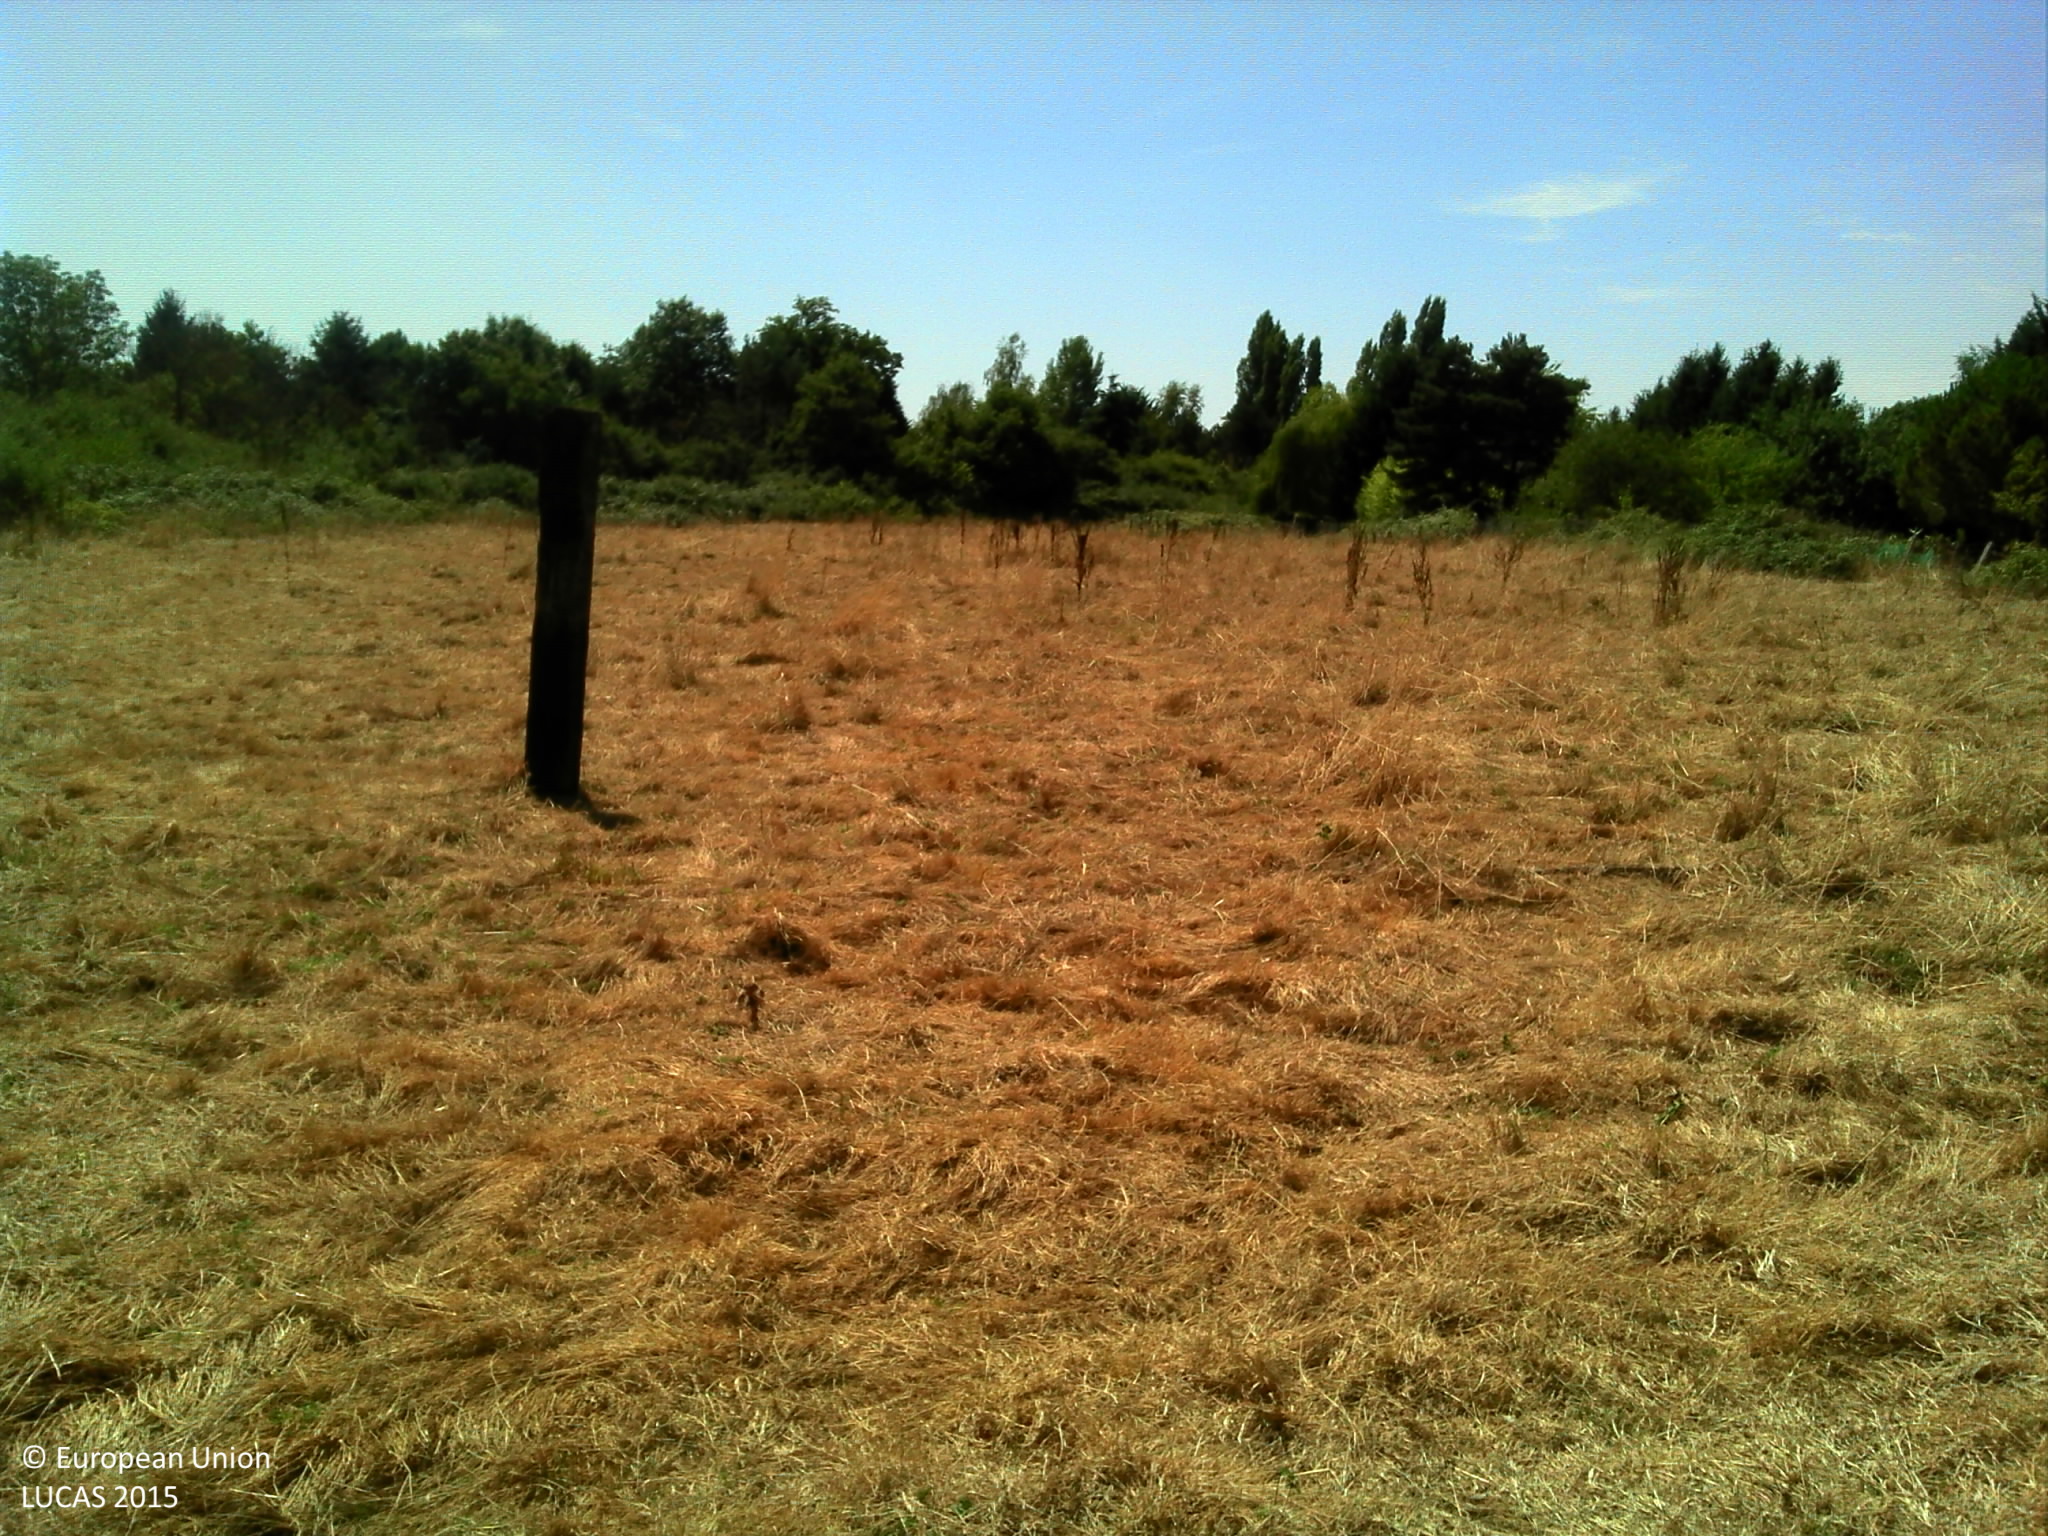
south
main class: Grassland
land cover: Grassland without tree/shrub cover
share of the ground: > 75 %
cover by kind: herbaceous plants 100 %
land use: Agriculture (excluding fallow land and kitchen gardens)
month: August
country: FR
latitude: 47.2349
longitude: 2.1049
